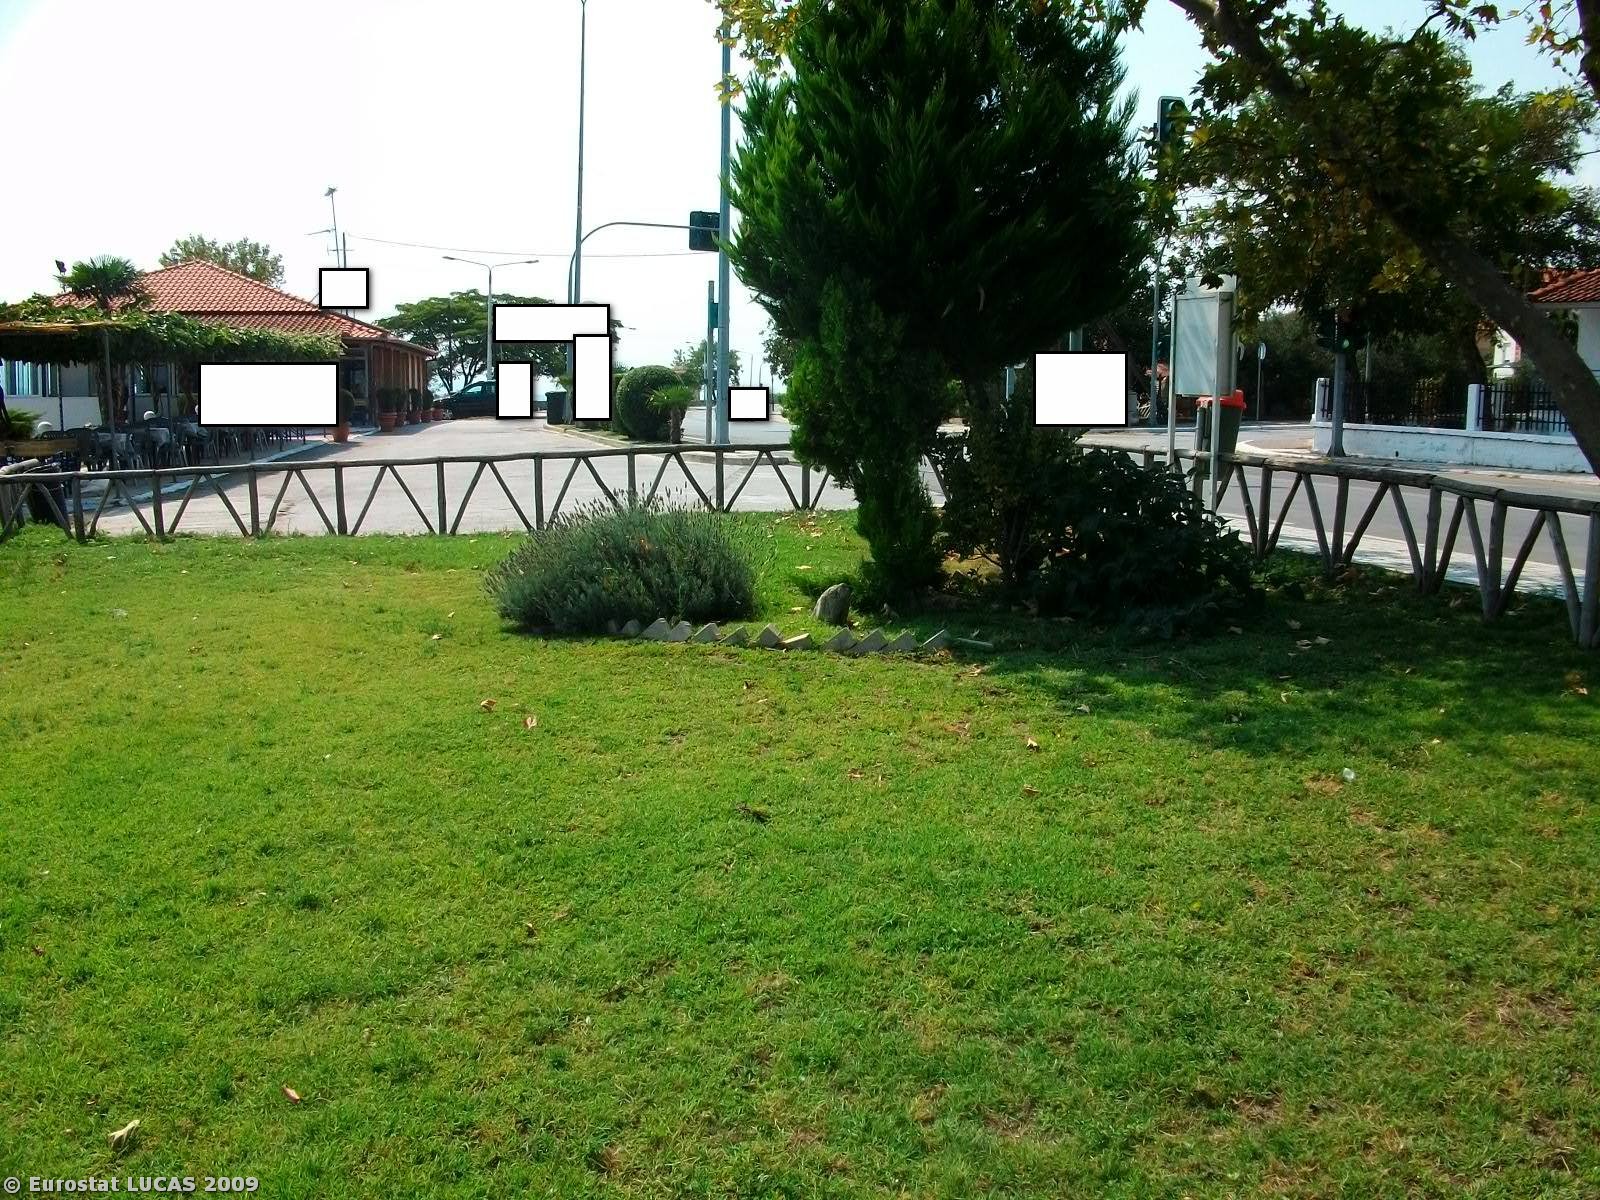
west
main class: Grassland
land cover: Grassland with sparse tree/shrub cover
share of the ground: > 75 %
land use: Amenities, museums, leisure
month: August
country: GR
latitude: 40.6760
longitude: 23.5615
